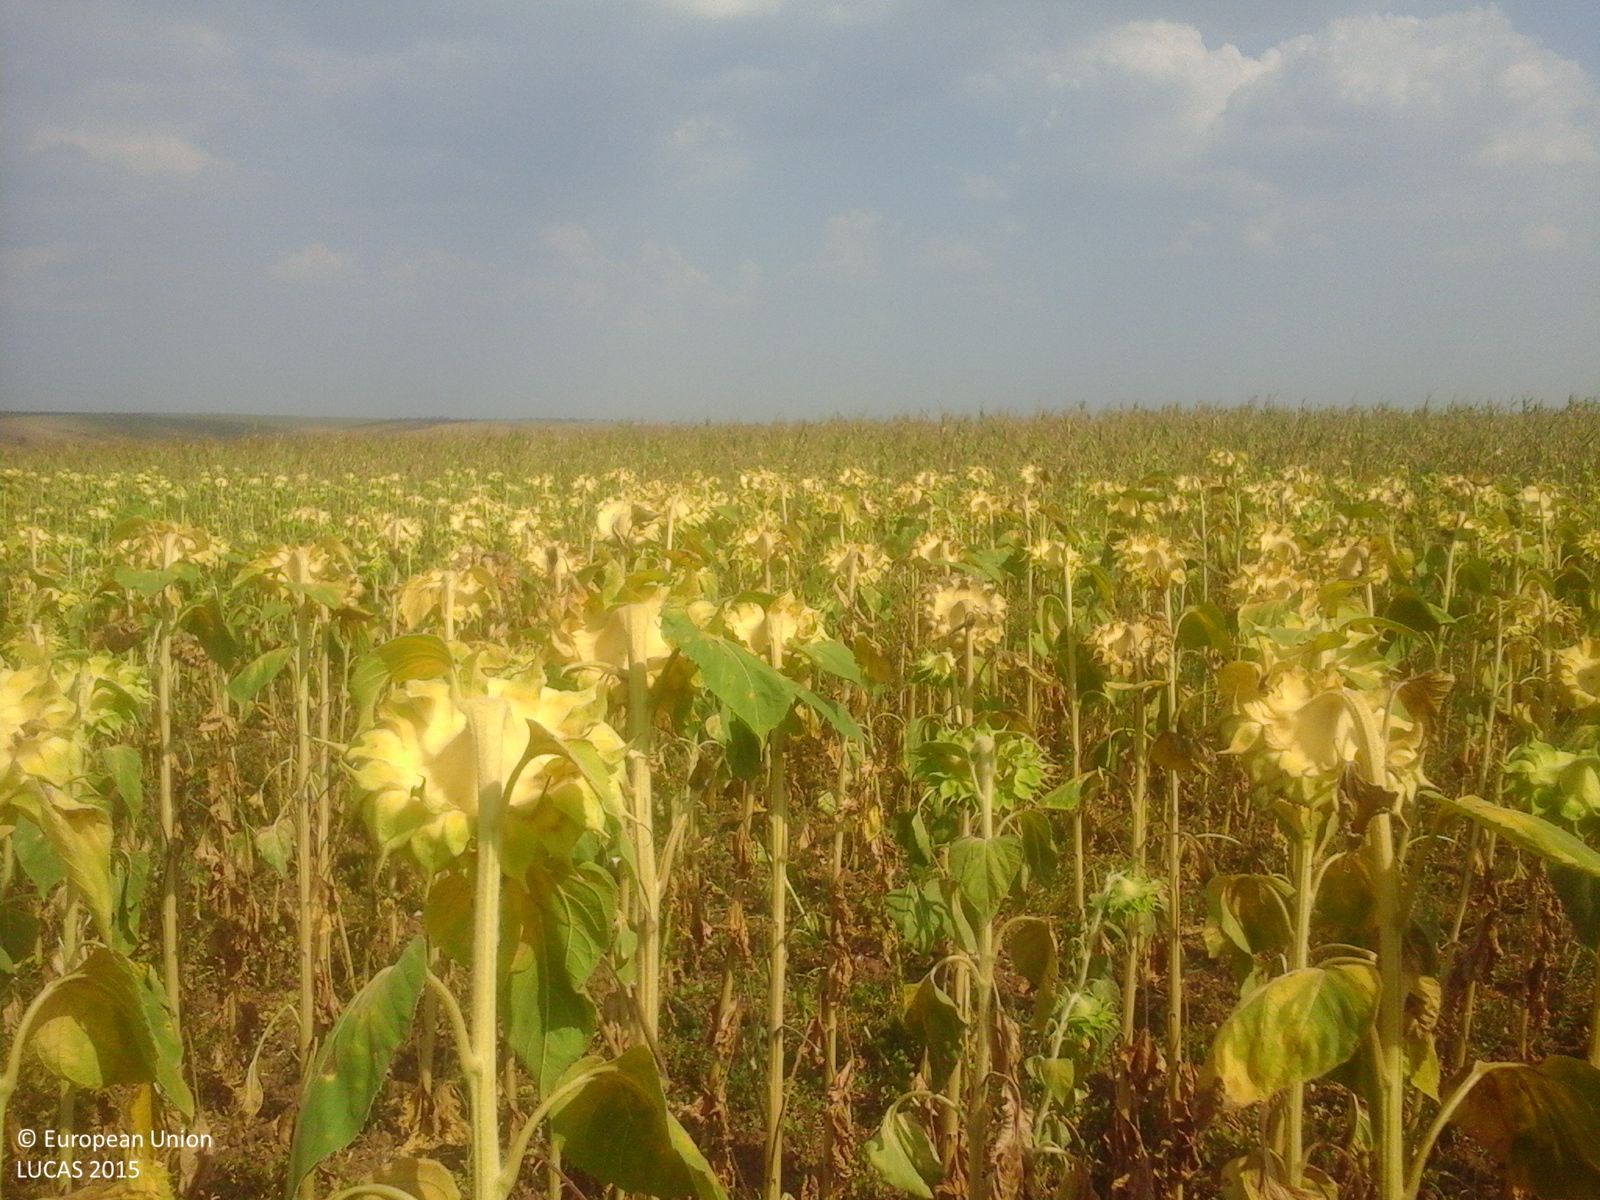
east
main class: Cropland
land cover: Sunflower
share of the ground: > 75 %
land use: Agriculture (excluding fallow land and kitchen gardens)
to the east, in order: Sunflower; Maize; Common wheat; Spontaneously vegetated surfaces; Tracks; Grass margins; Common wheat
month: August
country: RO
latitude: 44.3465
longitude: 23.0279
